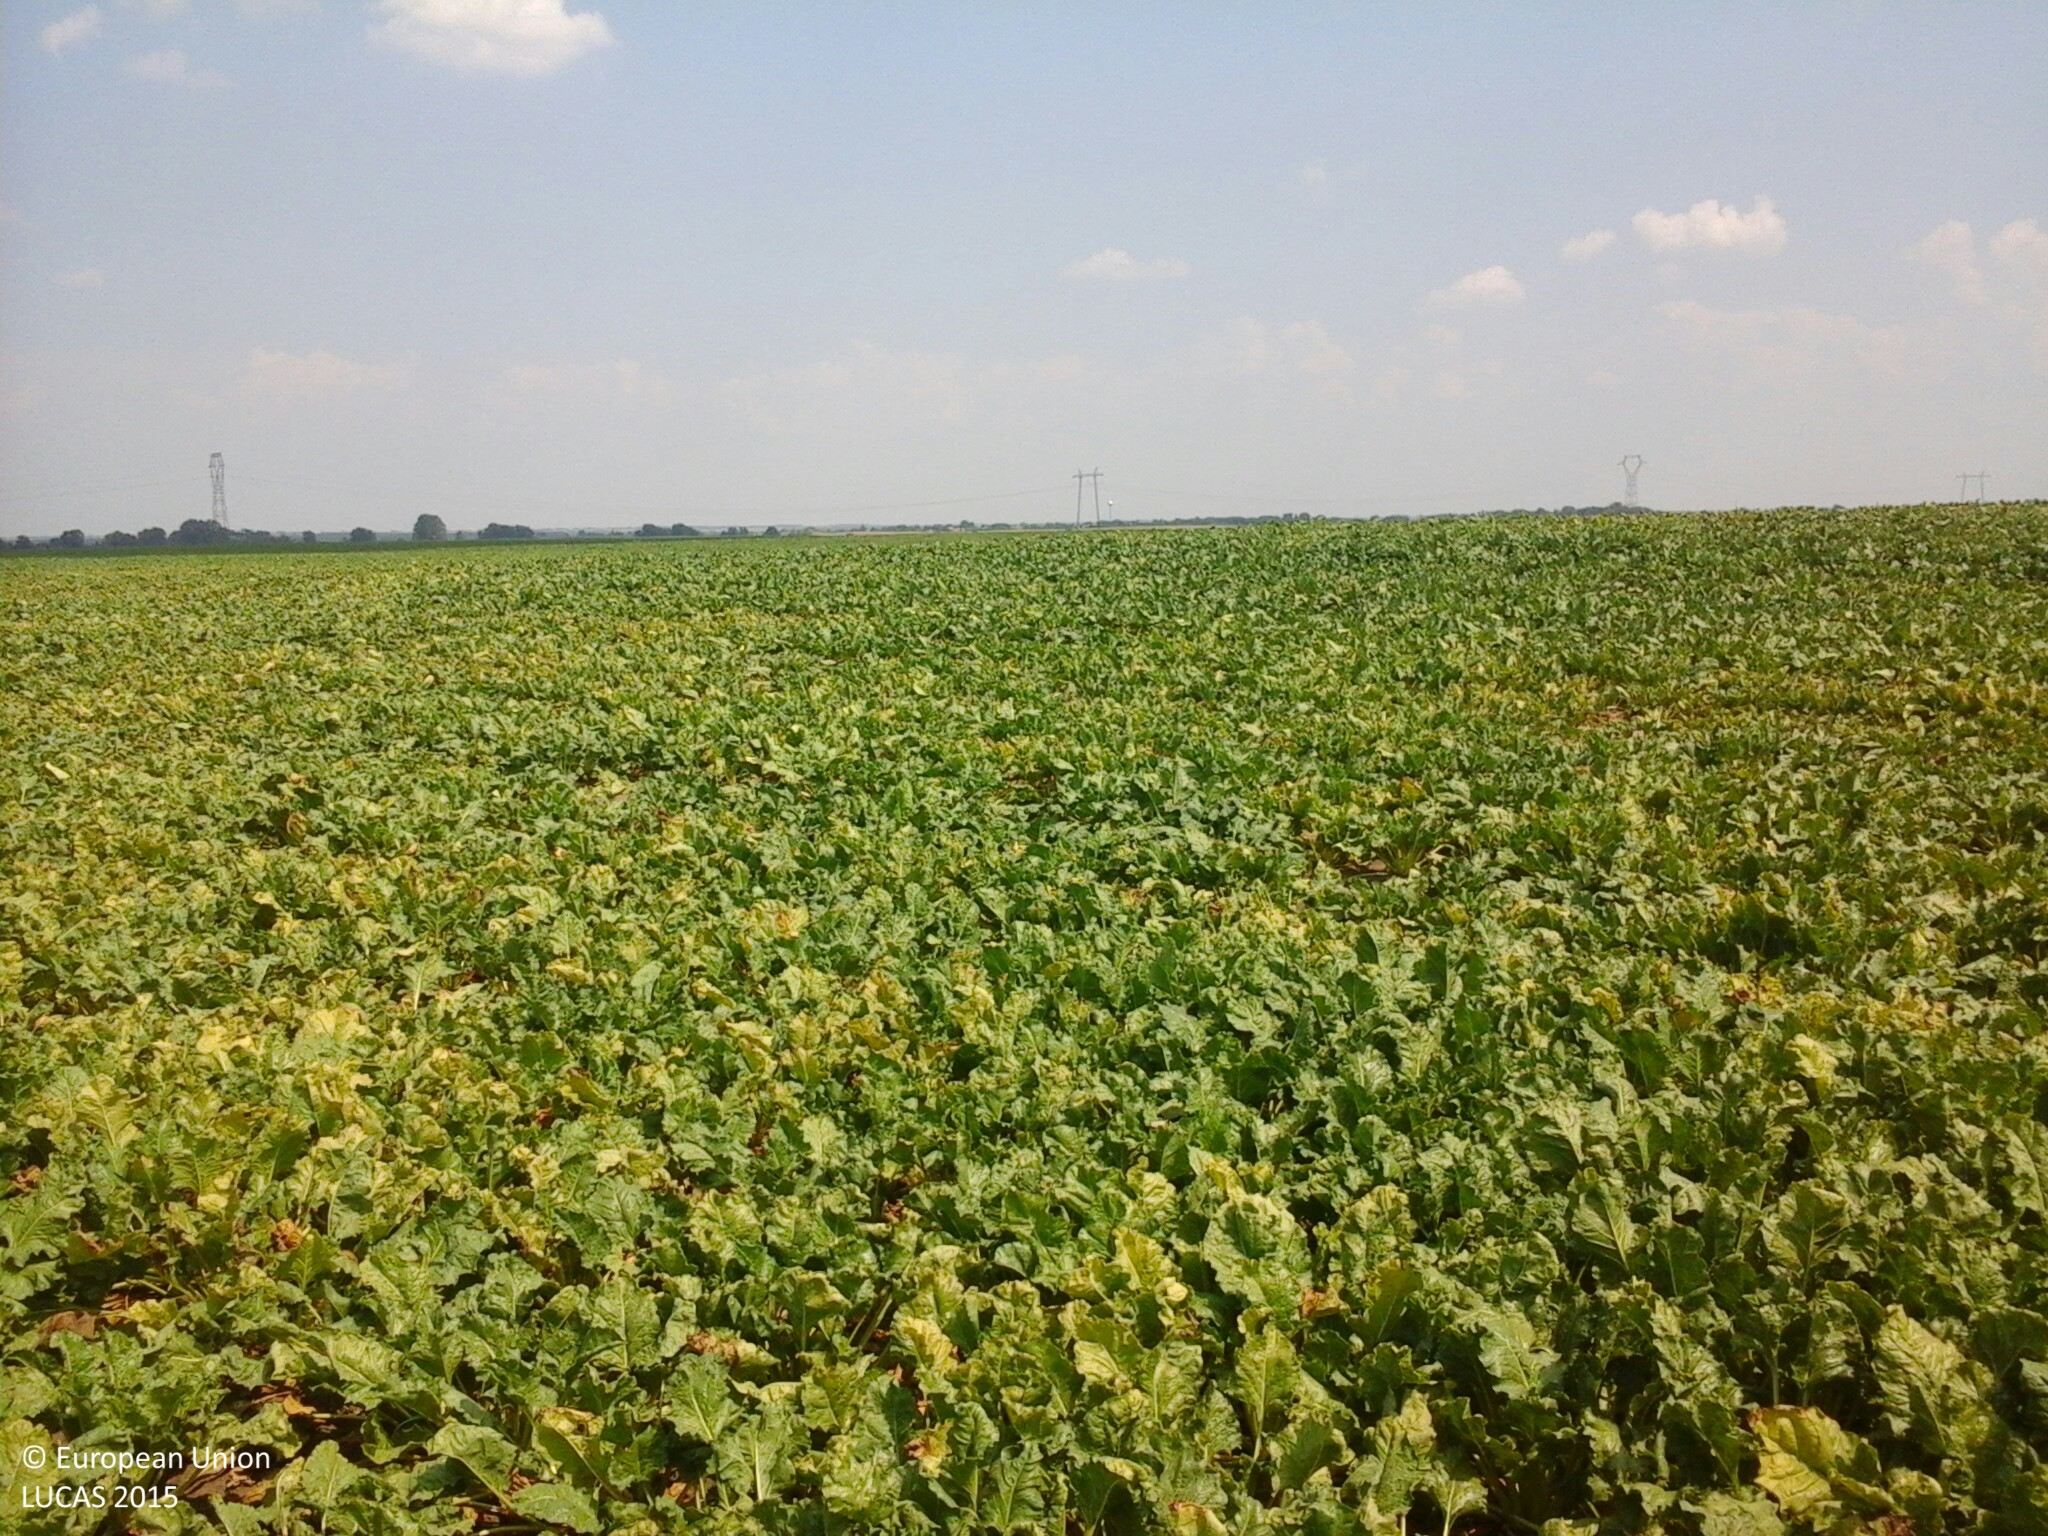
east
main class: Cropland
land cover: Sugar beet
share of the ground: > 75 %
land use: Agriculture (excluding fallow land and kitchen gardens)
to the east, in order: Sugar beet
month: August
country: HU
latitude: 46.8557
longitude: 18.3656
